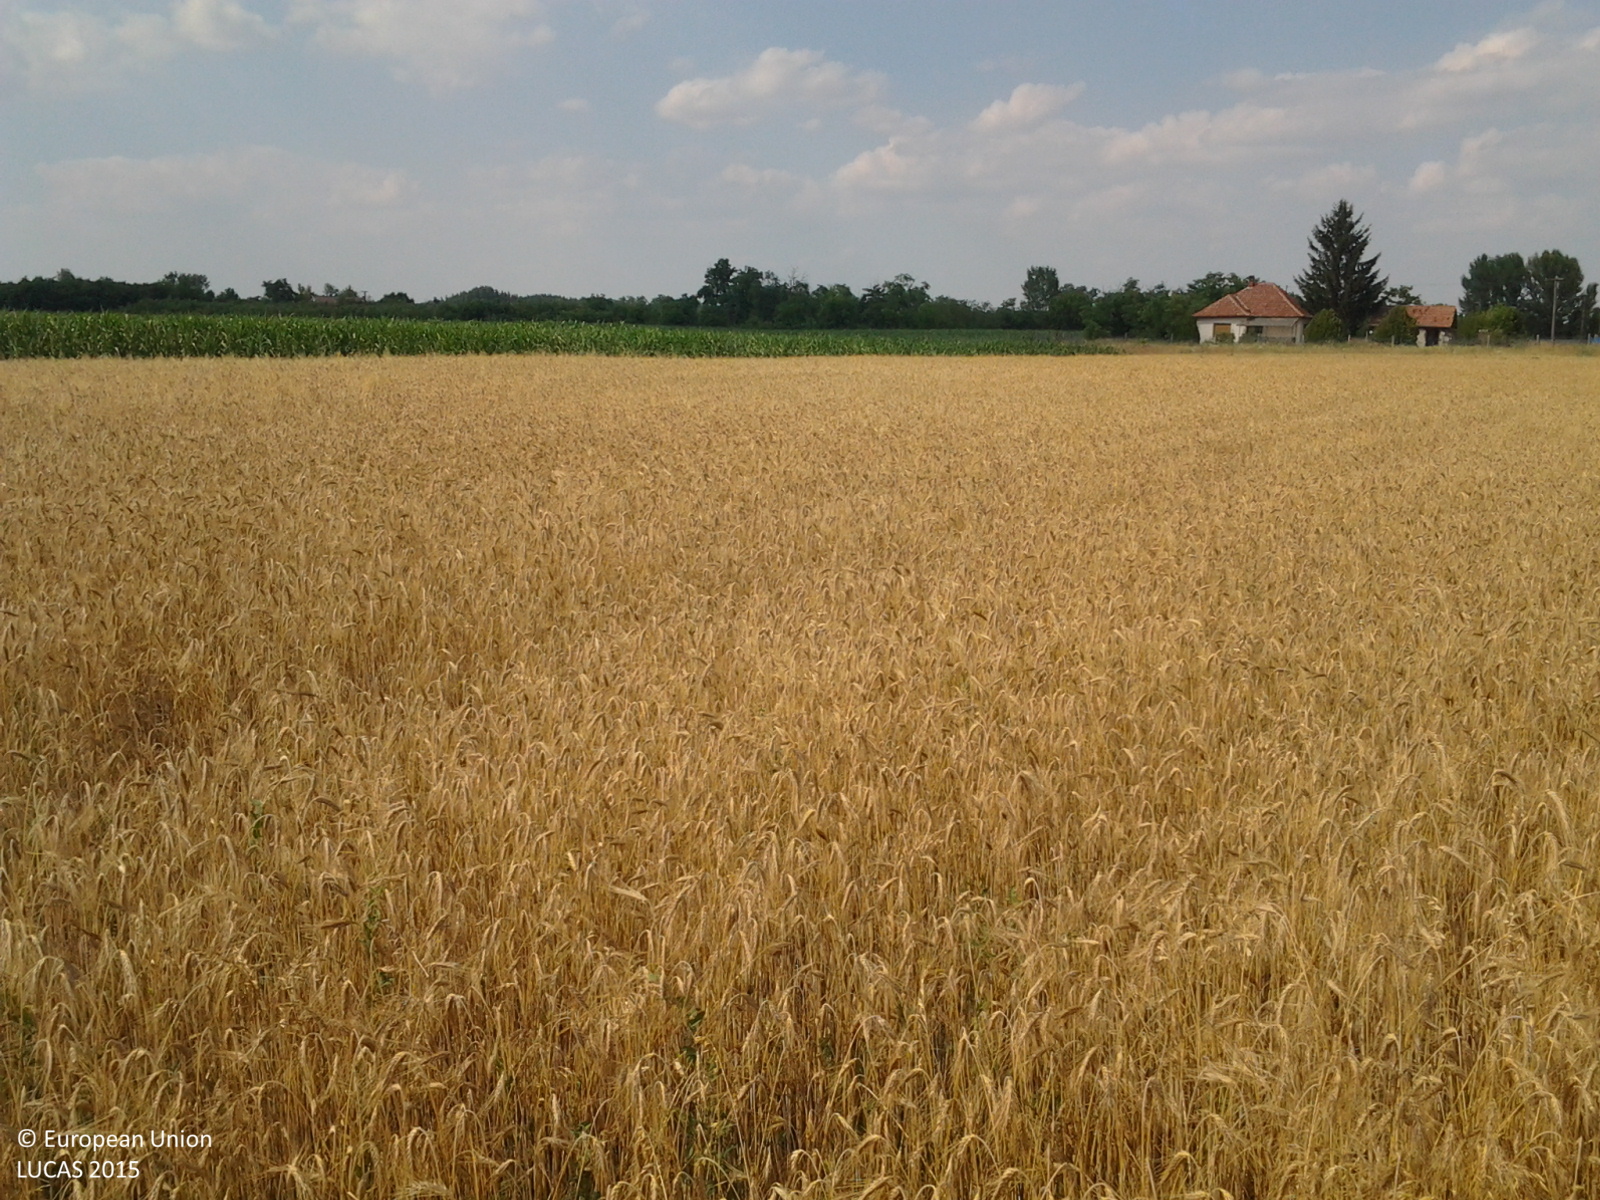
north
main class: Cropland
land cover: Triticale
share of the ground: > 75 %
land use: Agriculture (excluding fallow land and kitchen gardens)
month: July
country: HU
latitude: 47.4572
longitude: 19.8266
